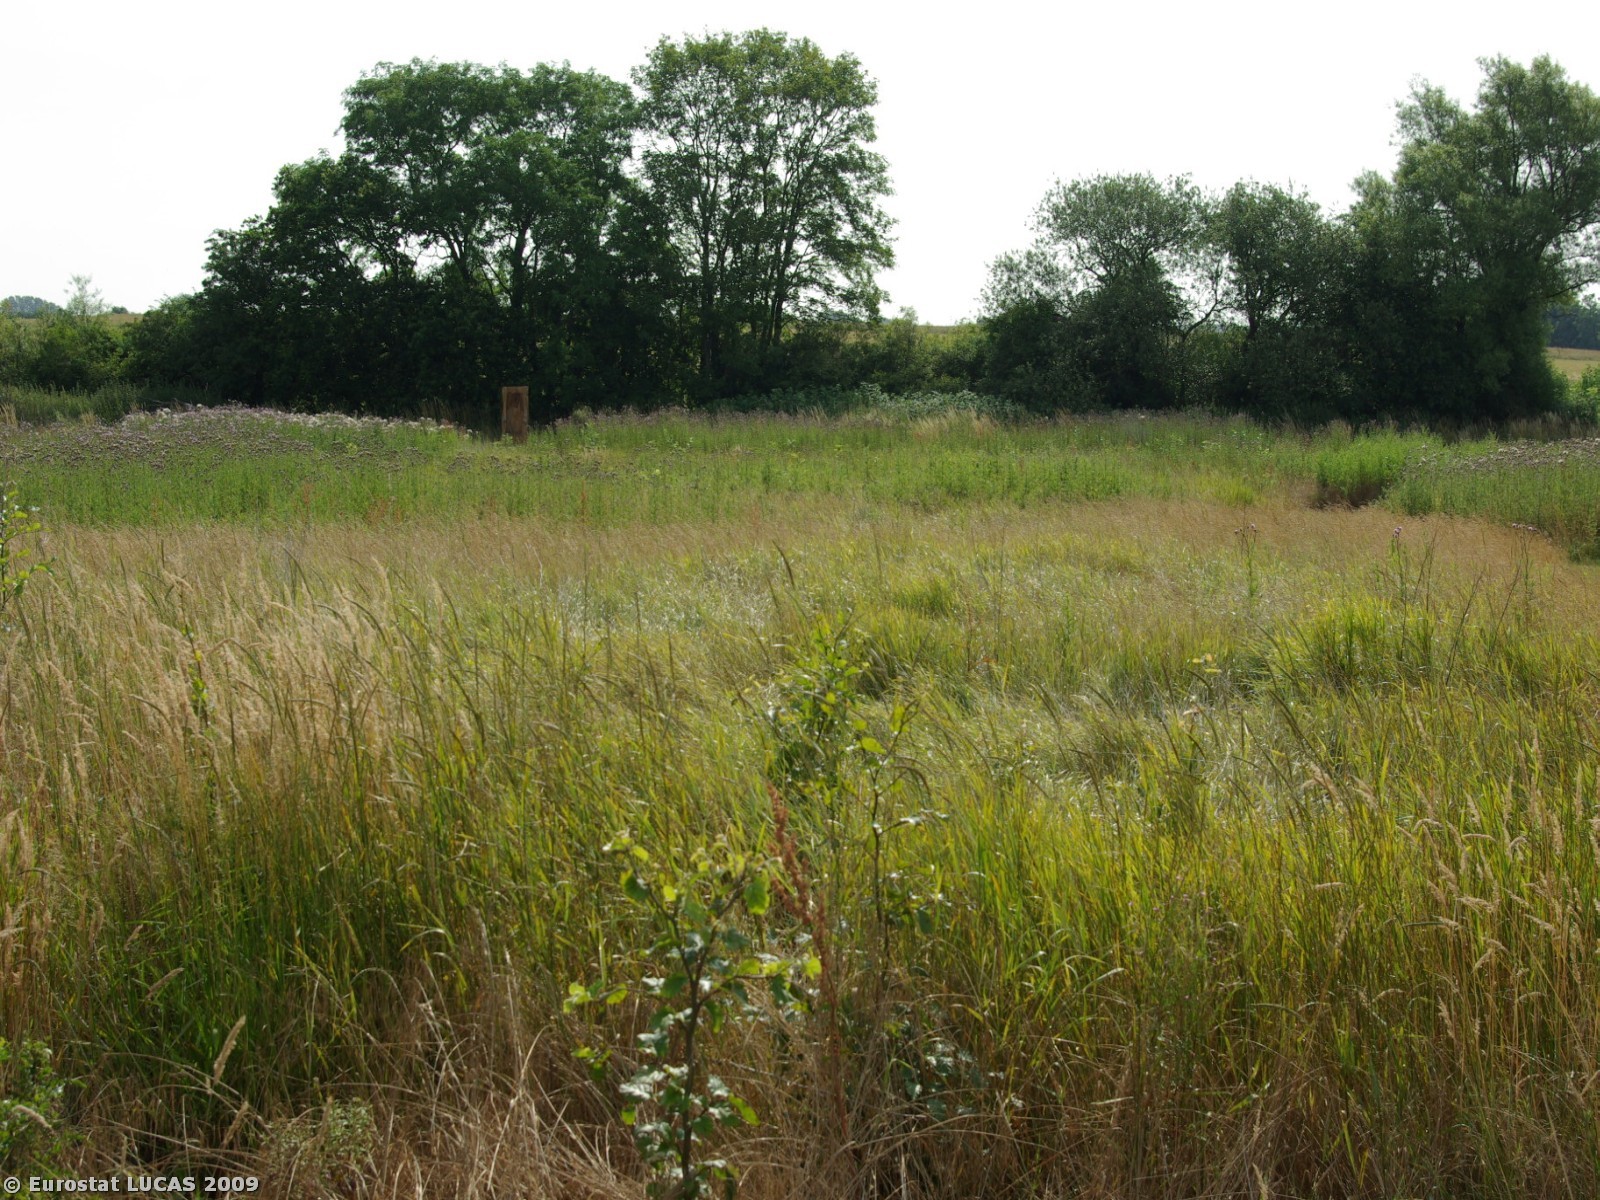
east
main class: Woodland
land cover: Broadleaved woodland
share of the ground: < 10 %
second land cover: Spontaneously vegetated surfaces
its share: > 75 %
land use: Amenities, museums, leisure
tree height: < 5 m
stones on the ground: < 10 %
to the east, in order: Broadleaved woodland; Spontaneously vegetated surfaces; Tracks; Spontaneously vegetated surfaces; Grassland without tree/shrub cover; Spontaneously vegetated surfaces; Ditches and canals; Broadleaved woodland; Grassland without tree/shrub cover; Grass margins; Tracks; Grass margins; Grassland without tree/shrub cover; Spontaneously vegetated surfaces; Common wheat
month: July
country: DK
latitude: 54.9291
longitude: 9.6725
